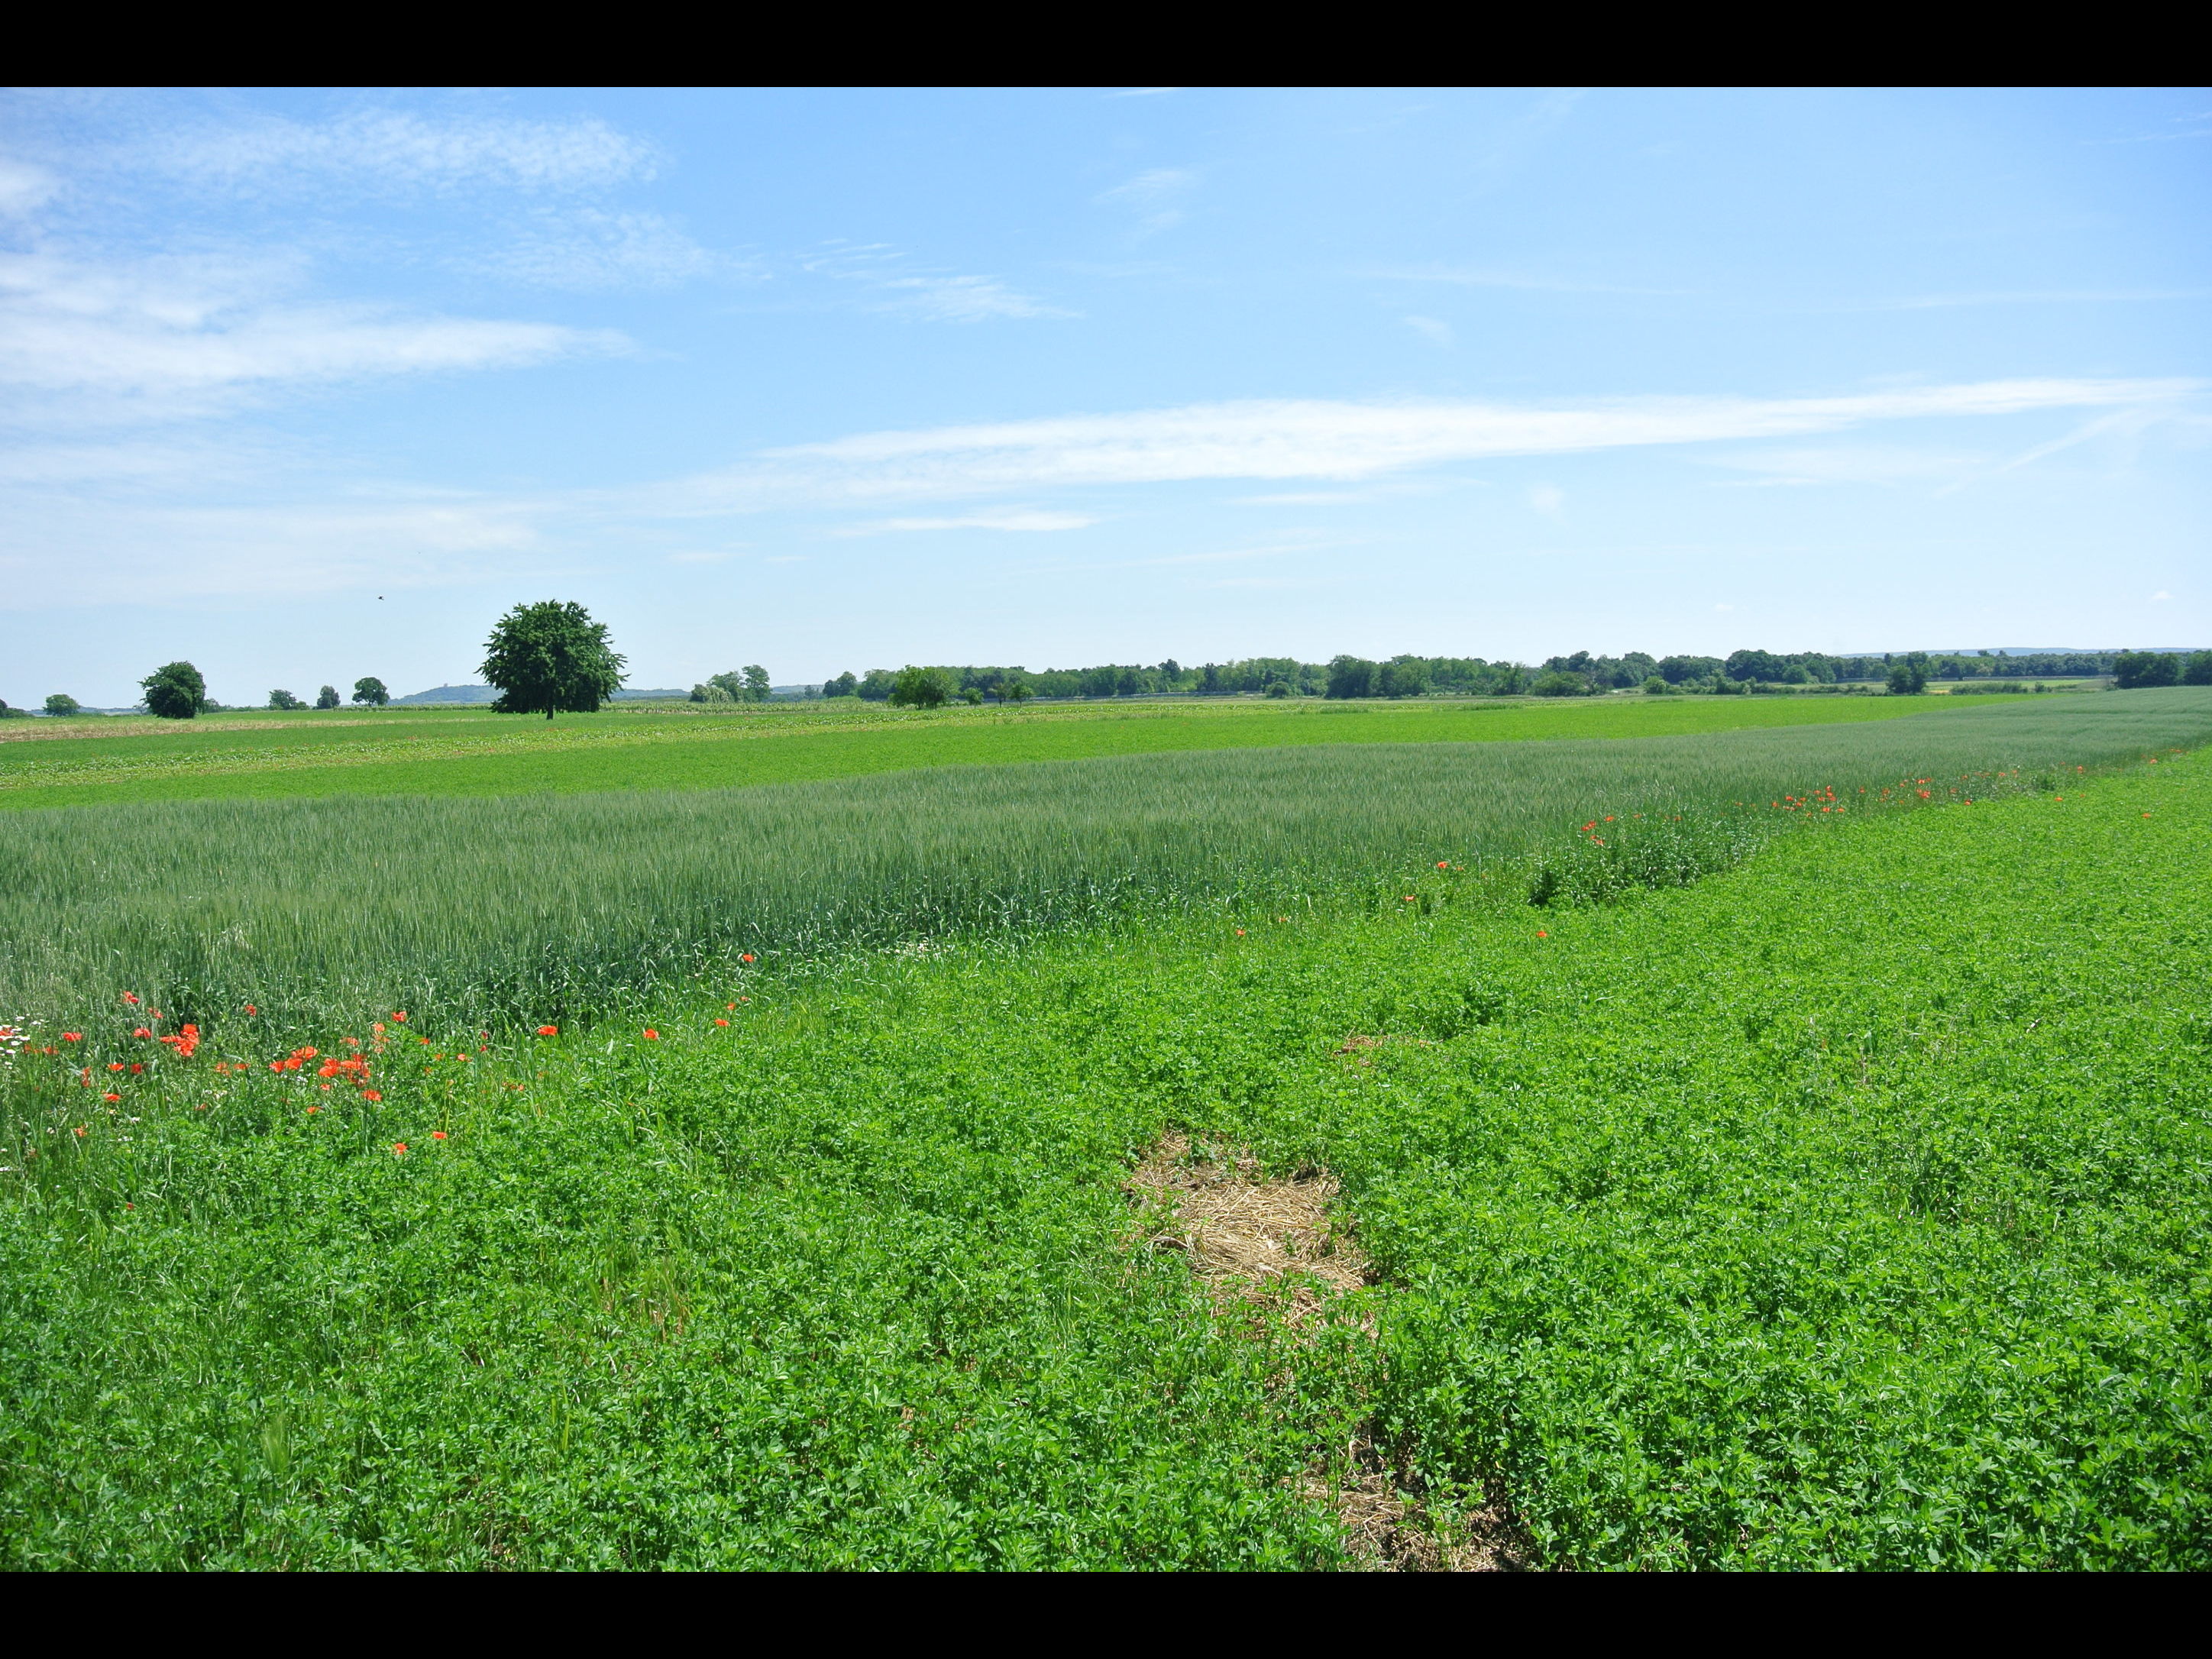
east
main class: Cropland
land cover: Clovers
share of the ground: > 75 %
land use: Agriculture (excluding fallow land and kitchen gardens)
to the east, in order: Clovers; Common wheat; Clovers; Barley; Other bare soil; Barley; Grass margins; Paved roads, cycling and walking lanes; Grass margins; Clovers
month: June
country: AT
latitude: 47.8114
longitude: 16.5617
